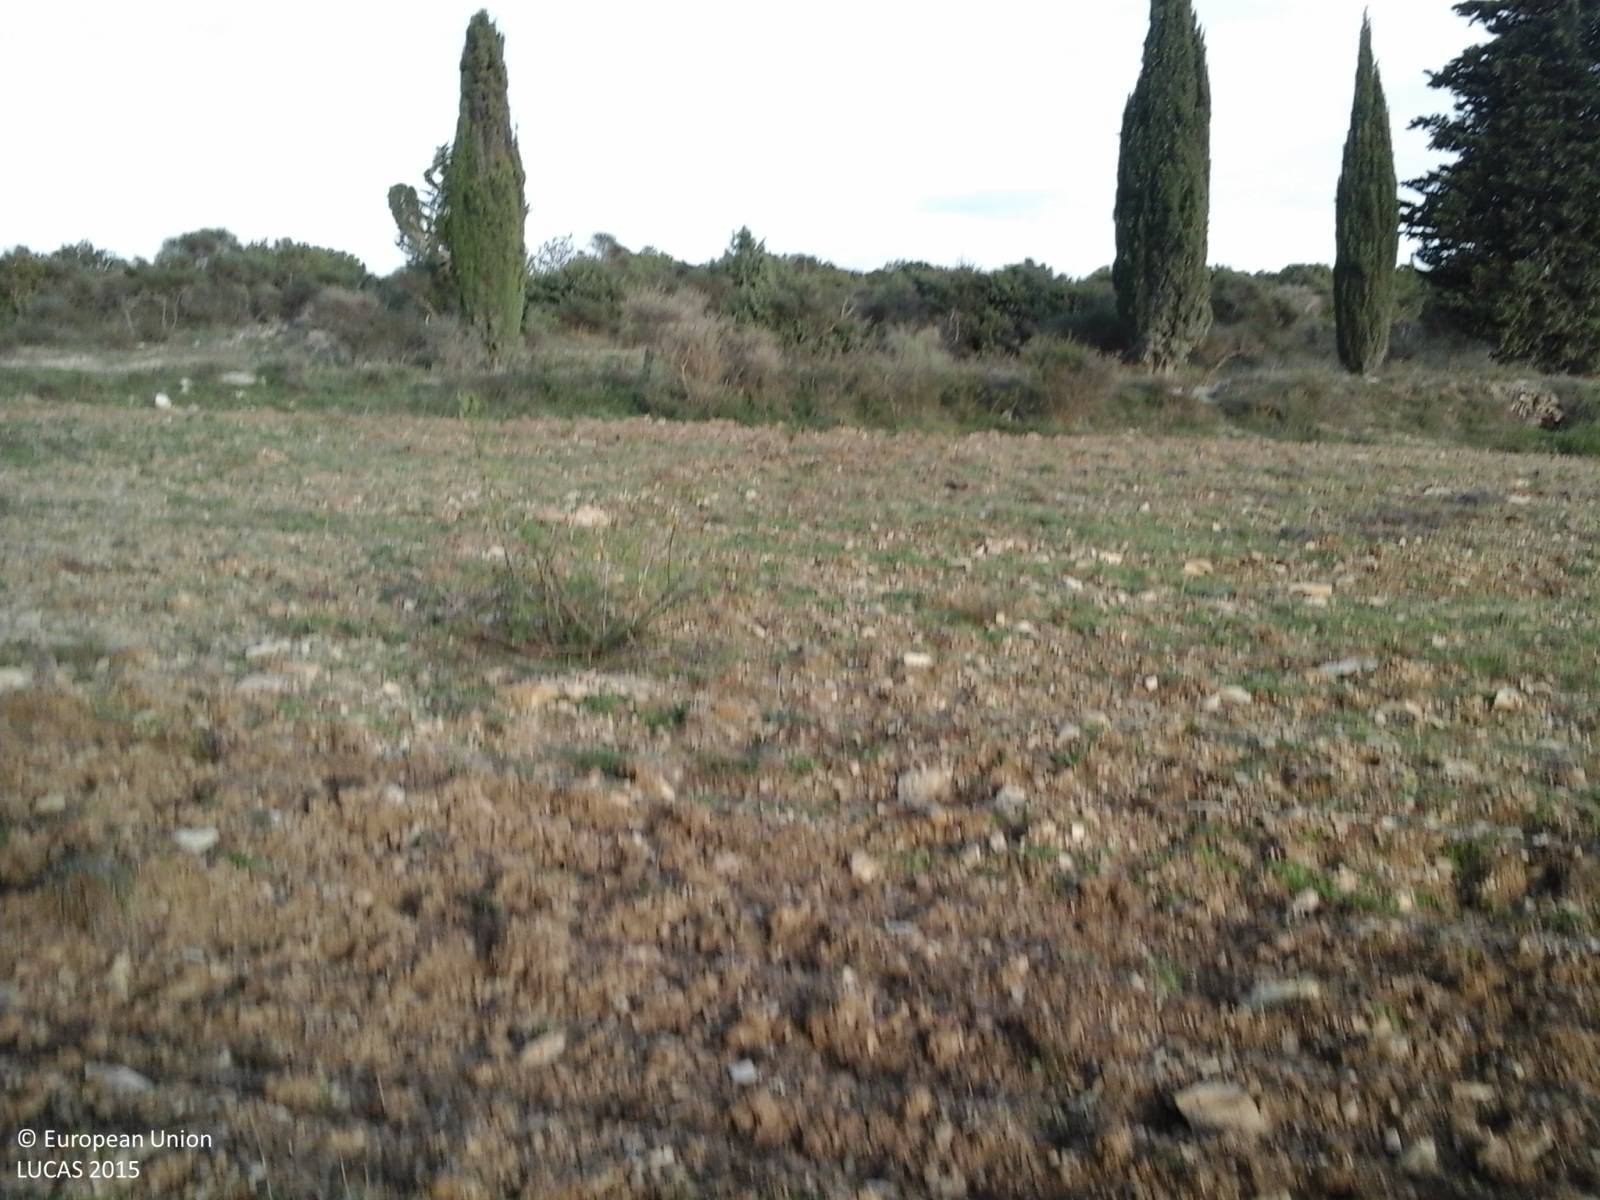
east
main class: Woodland
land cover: Broadleaved woodland
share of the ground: > 75 %
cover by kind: broadleaved forest trees 70 %, shrubs 30 %
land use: Agriculture (excluding fallow land and kitchen gardens)
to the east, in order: Broadleaved woodland; Spontaneously vegetated surfaces; Grass margins; Tracks; Grassland with sparse tree/shrub cover; Tracks; Grassland with sparse tree/shrub cover; Shrubland with sparse tree cover; Tracks; Shrubland with sparse tree cover; Grassland with sparse tree/shrub cover
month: October
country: IT
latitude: 42.7729
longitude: 12.2783
